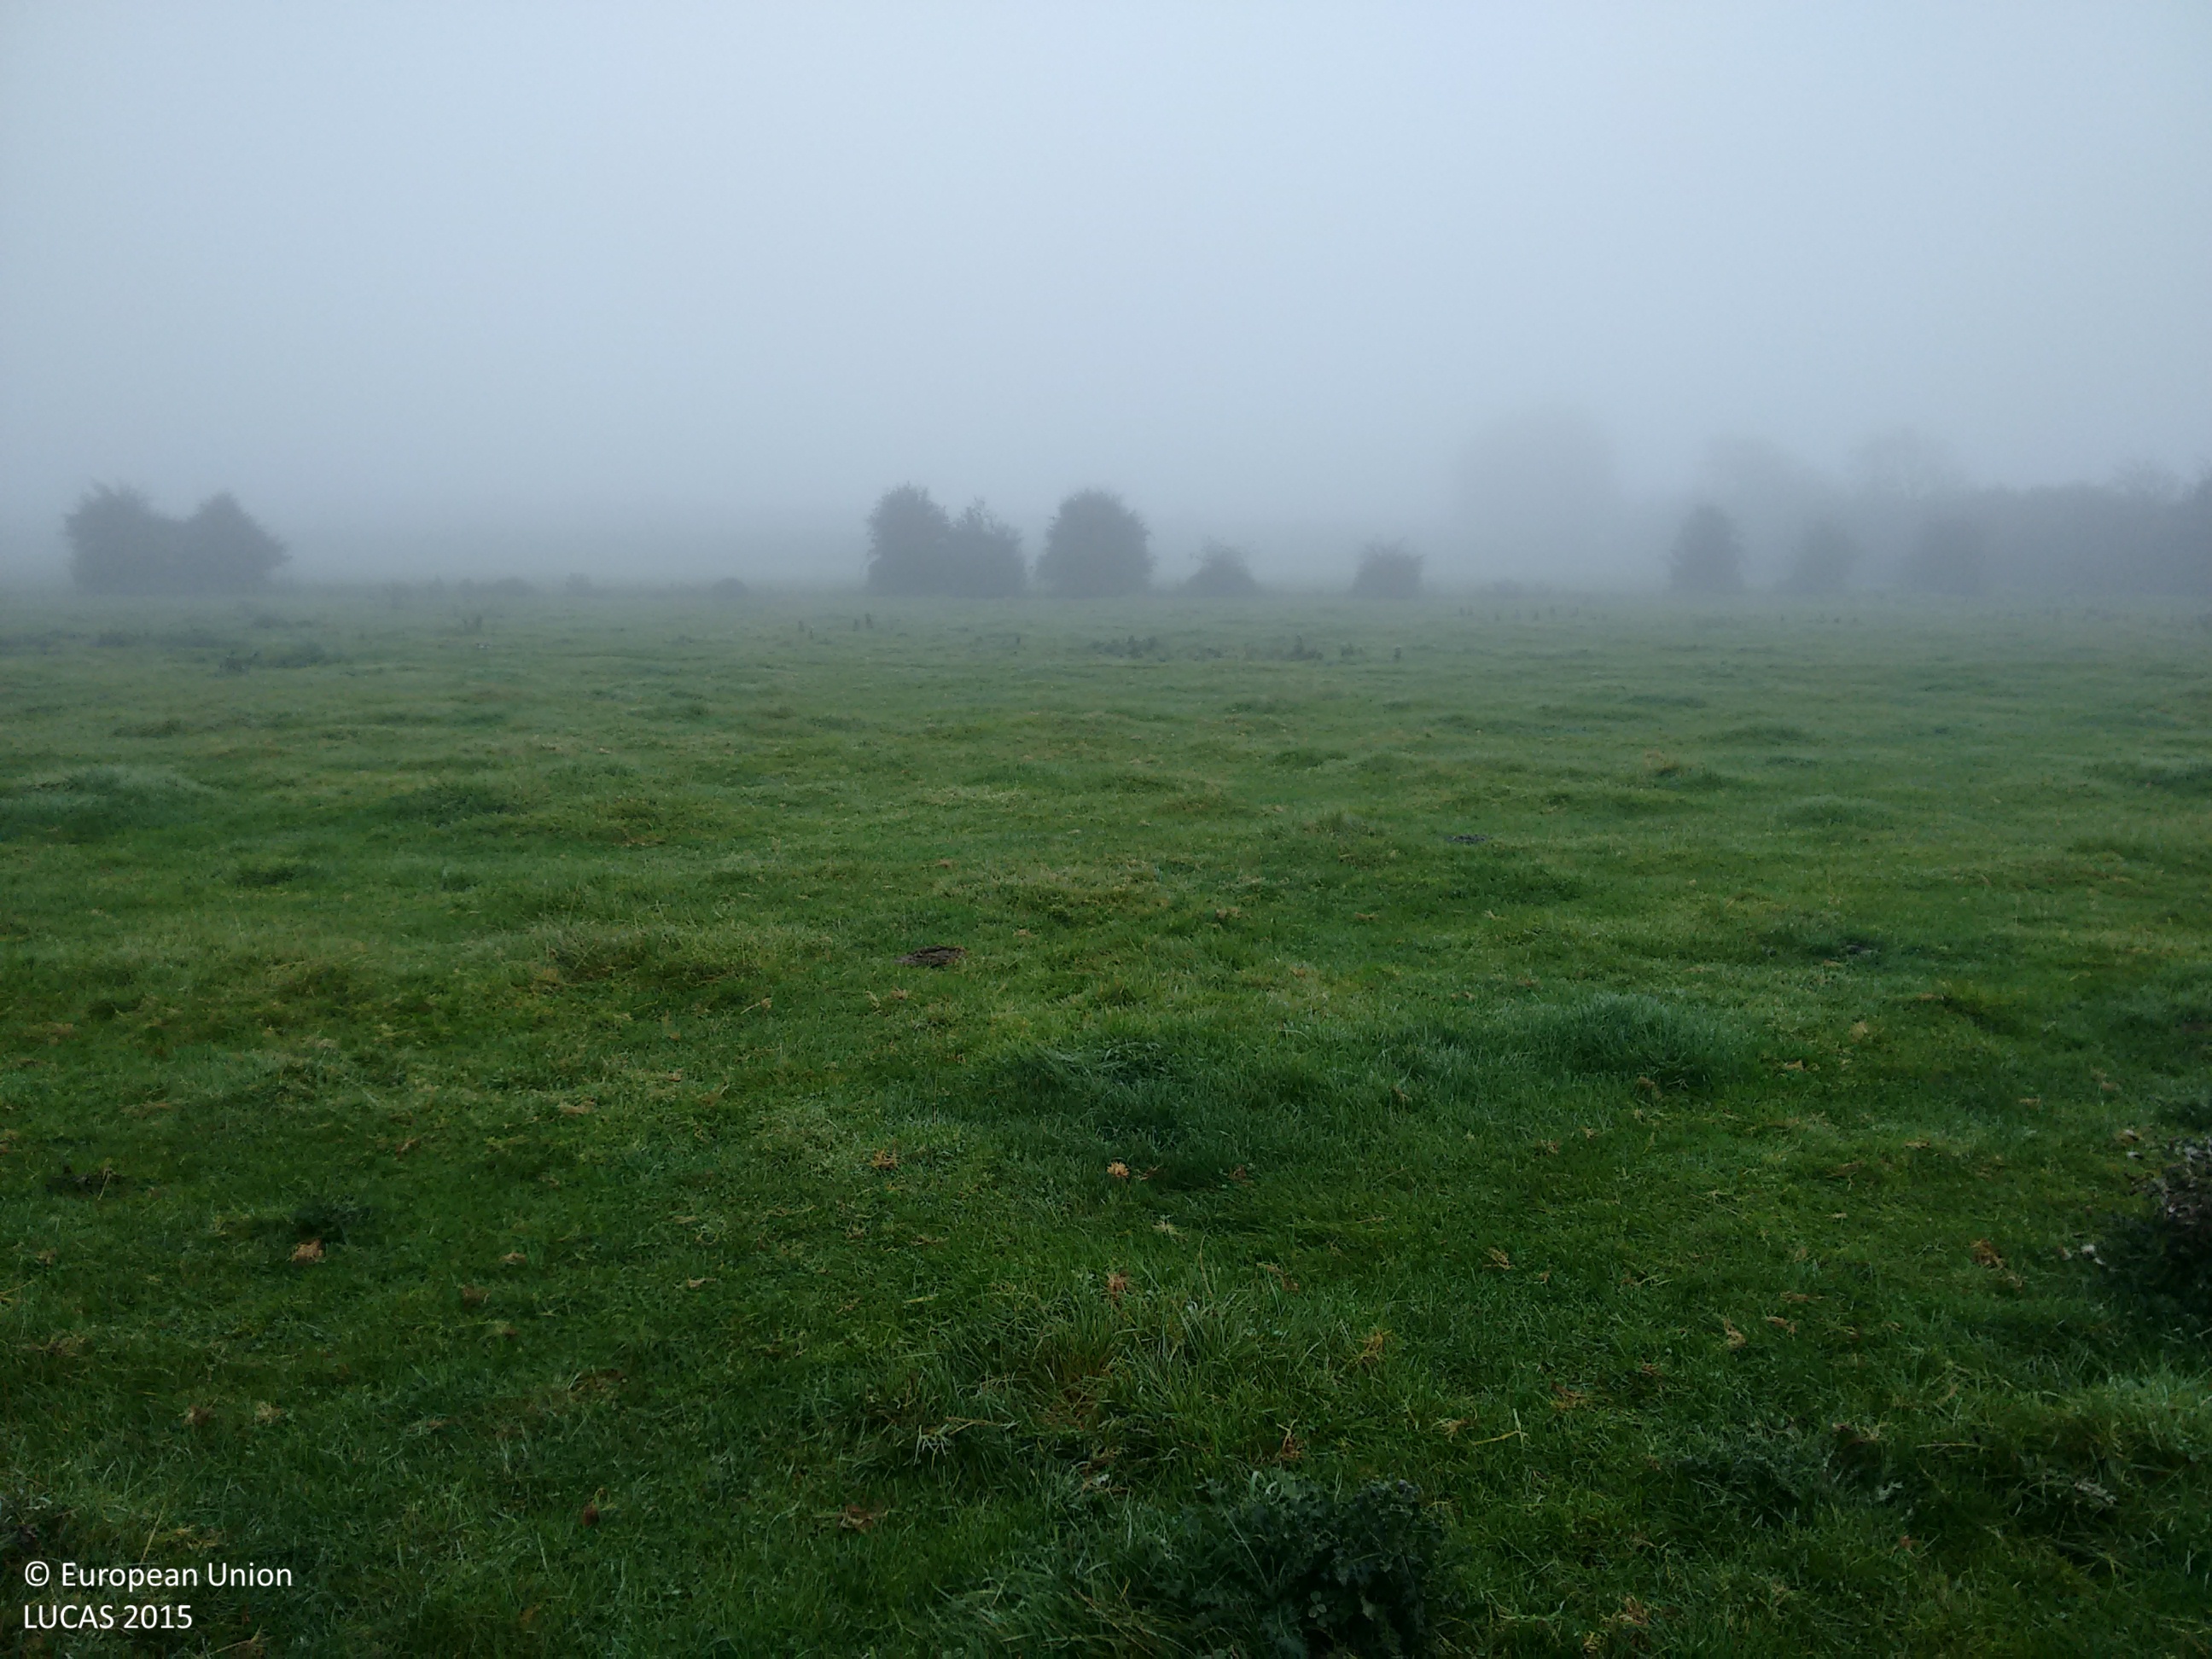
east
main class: Grassland
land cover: Grassland without tree/shrub cover
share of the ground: > 75 %
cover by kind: herbaceous plants 100 %
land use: Agriculture (excluding fallow land and kitchen gardens)
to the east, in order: Abandoned hedges; Fences; Grassland without tree/shrub cover; Ditches and canals; Abandoned hedges; Grassland without tree/shrub cover; Fences; Abandoned hedges; Fences; Grassland without tree/shrub cover; Fences; Abandoned hedges; Fences; Grassland without tree/shrub cover
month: October
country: IE
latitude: 52.6390
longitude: -7.7985
